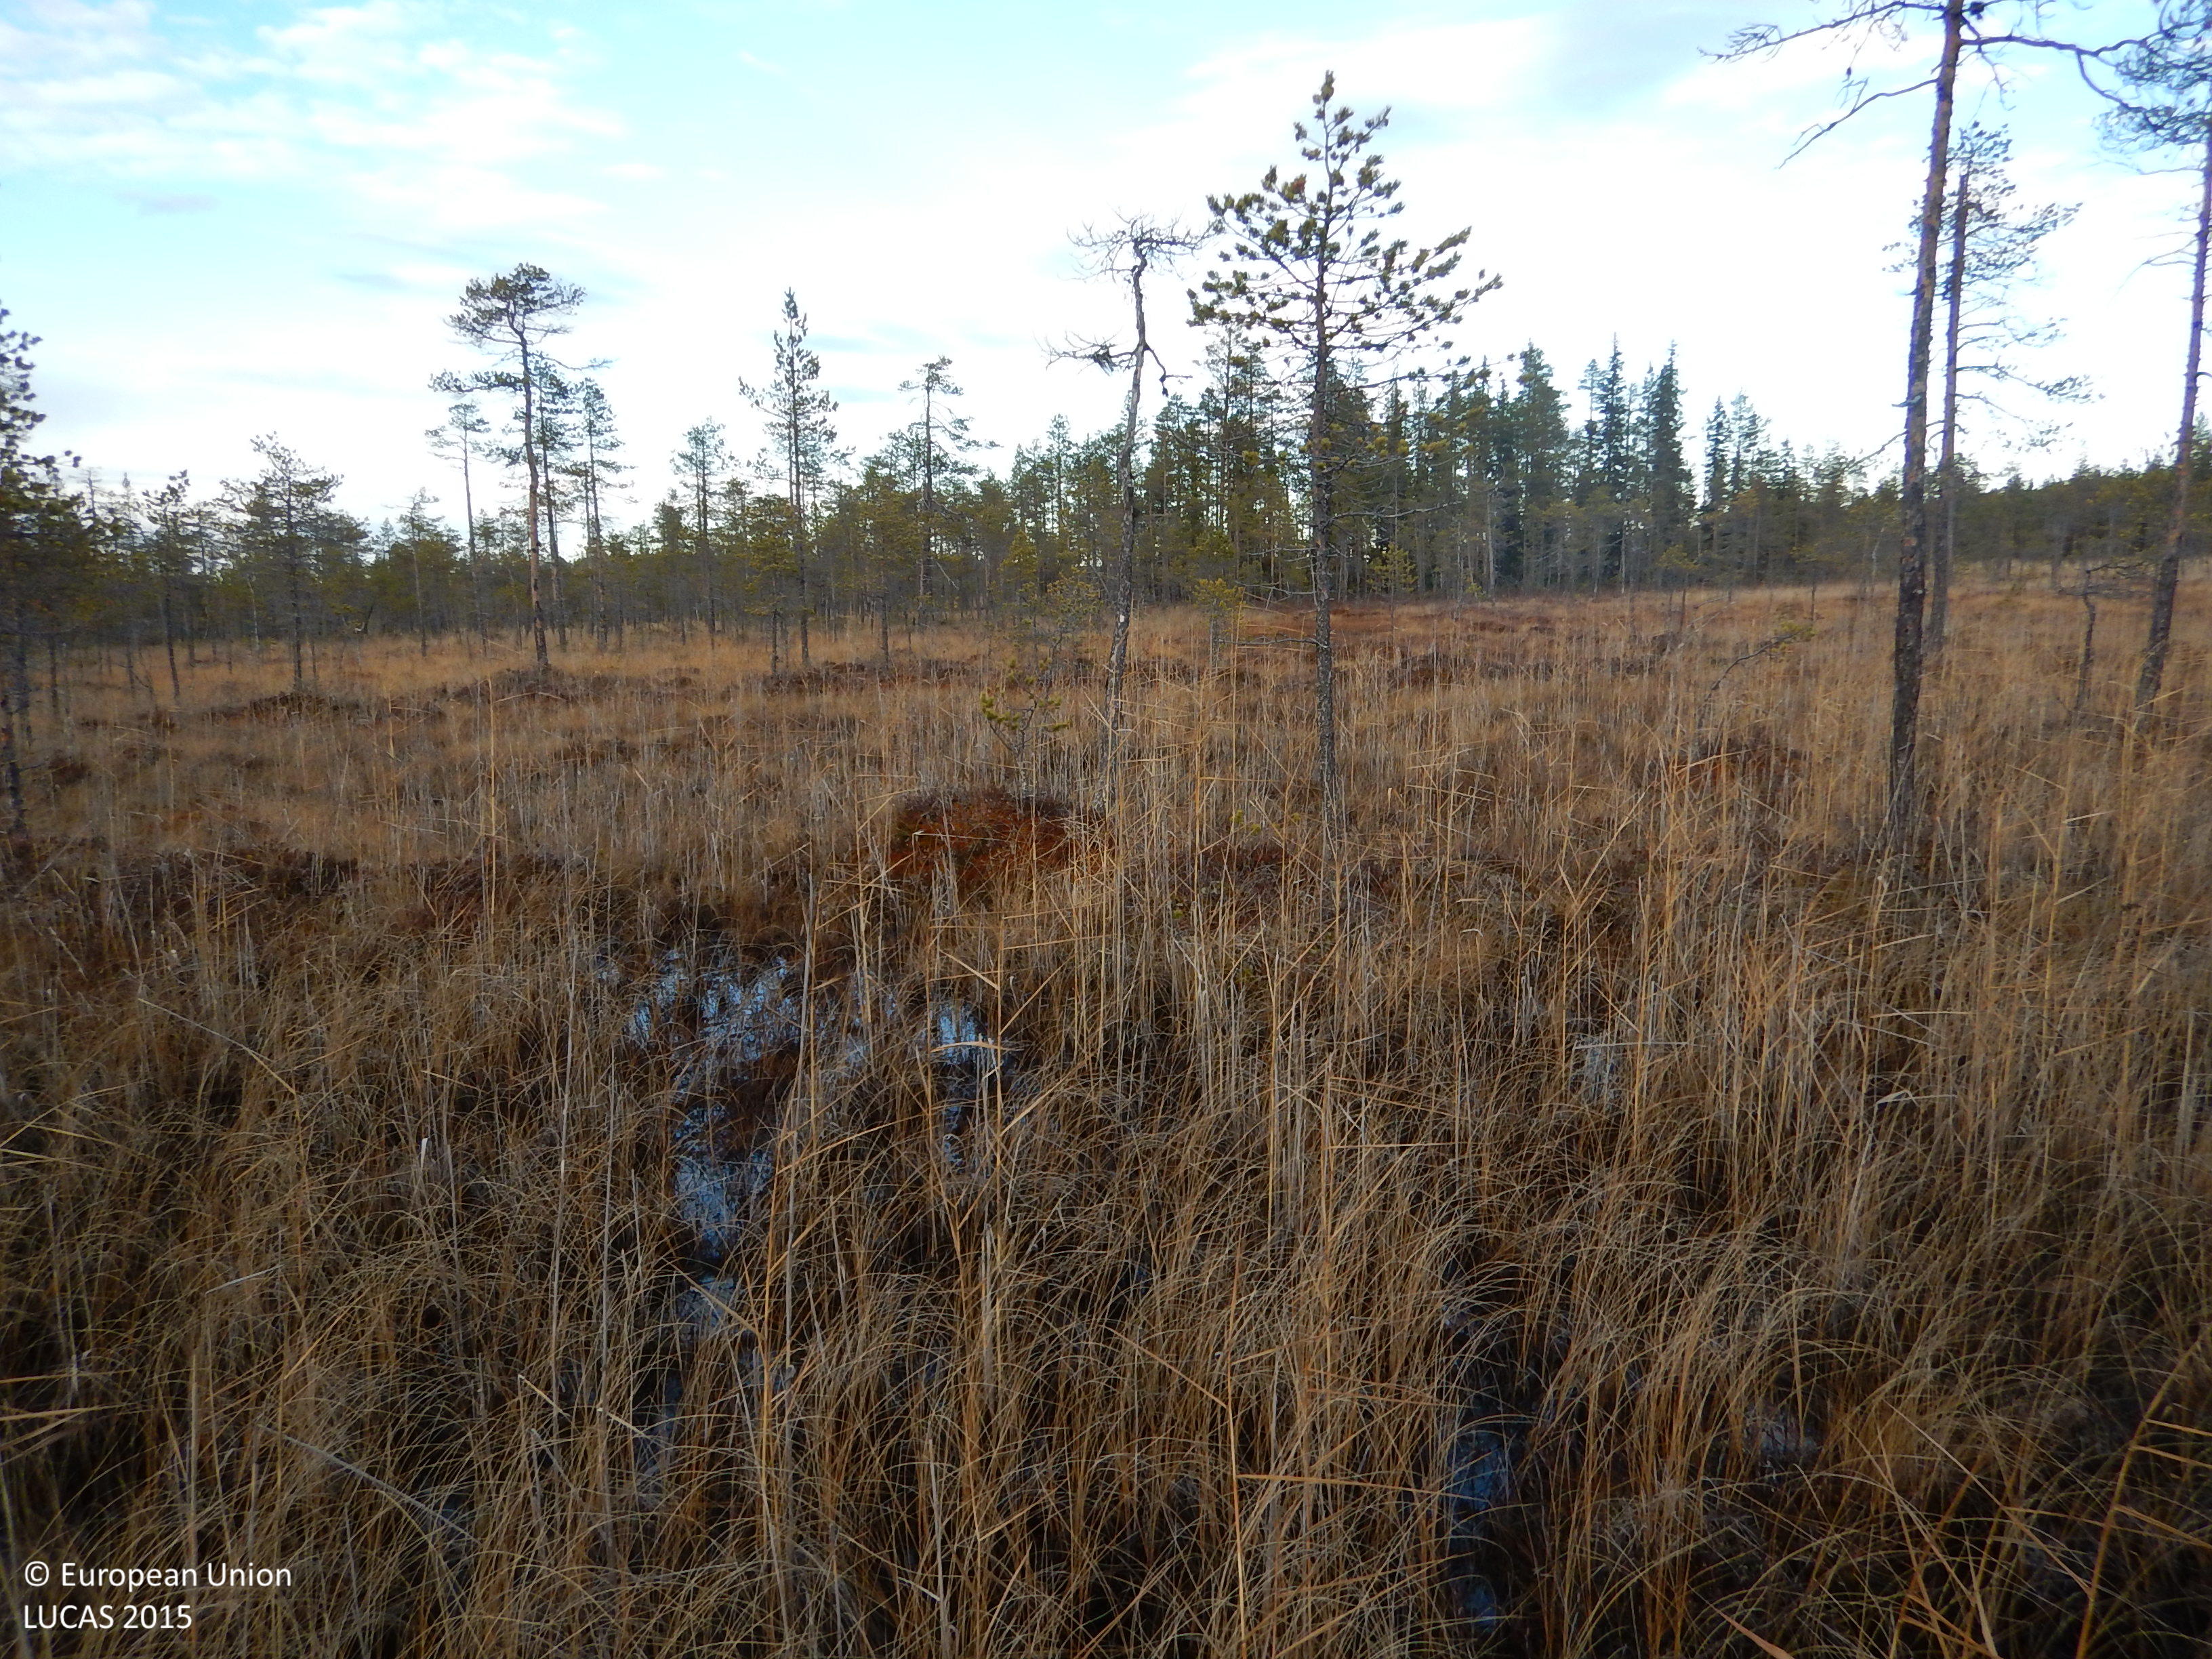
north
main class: Woodland
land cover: Pine dominated coniferous woodland
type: mire and swamp forests
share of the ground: 25 - 50 %
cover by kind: coniferous forest trees 30 %, lichens and mosses 30 %, herbaceous plants 20 %, shrubs 15 %, broadleaved forest trees 5 %
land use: Semi-natural and natural areas not in use
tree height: < 5 m
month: October
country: SE
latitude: 65.3201
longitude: 20.0329
